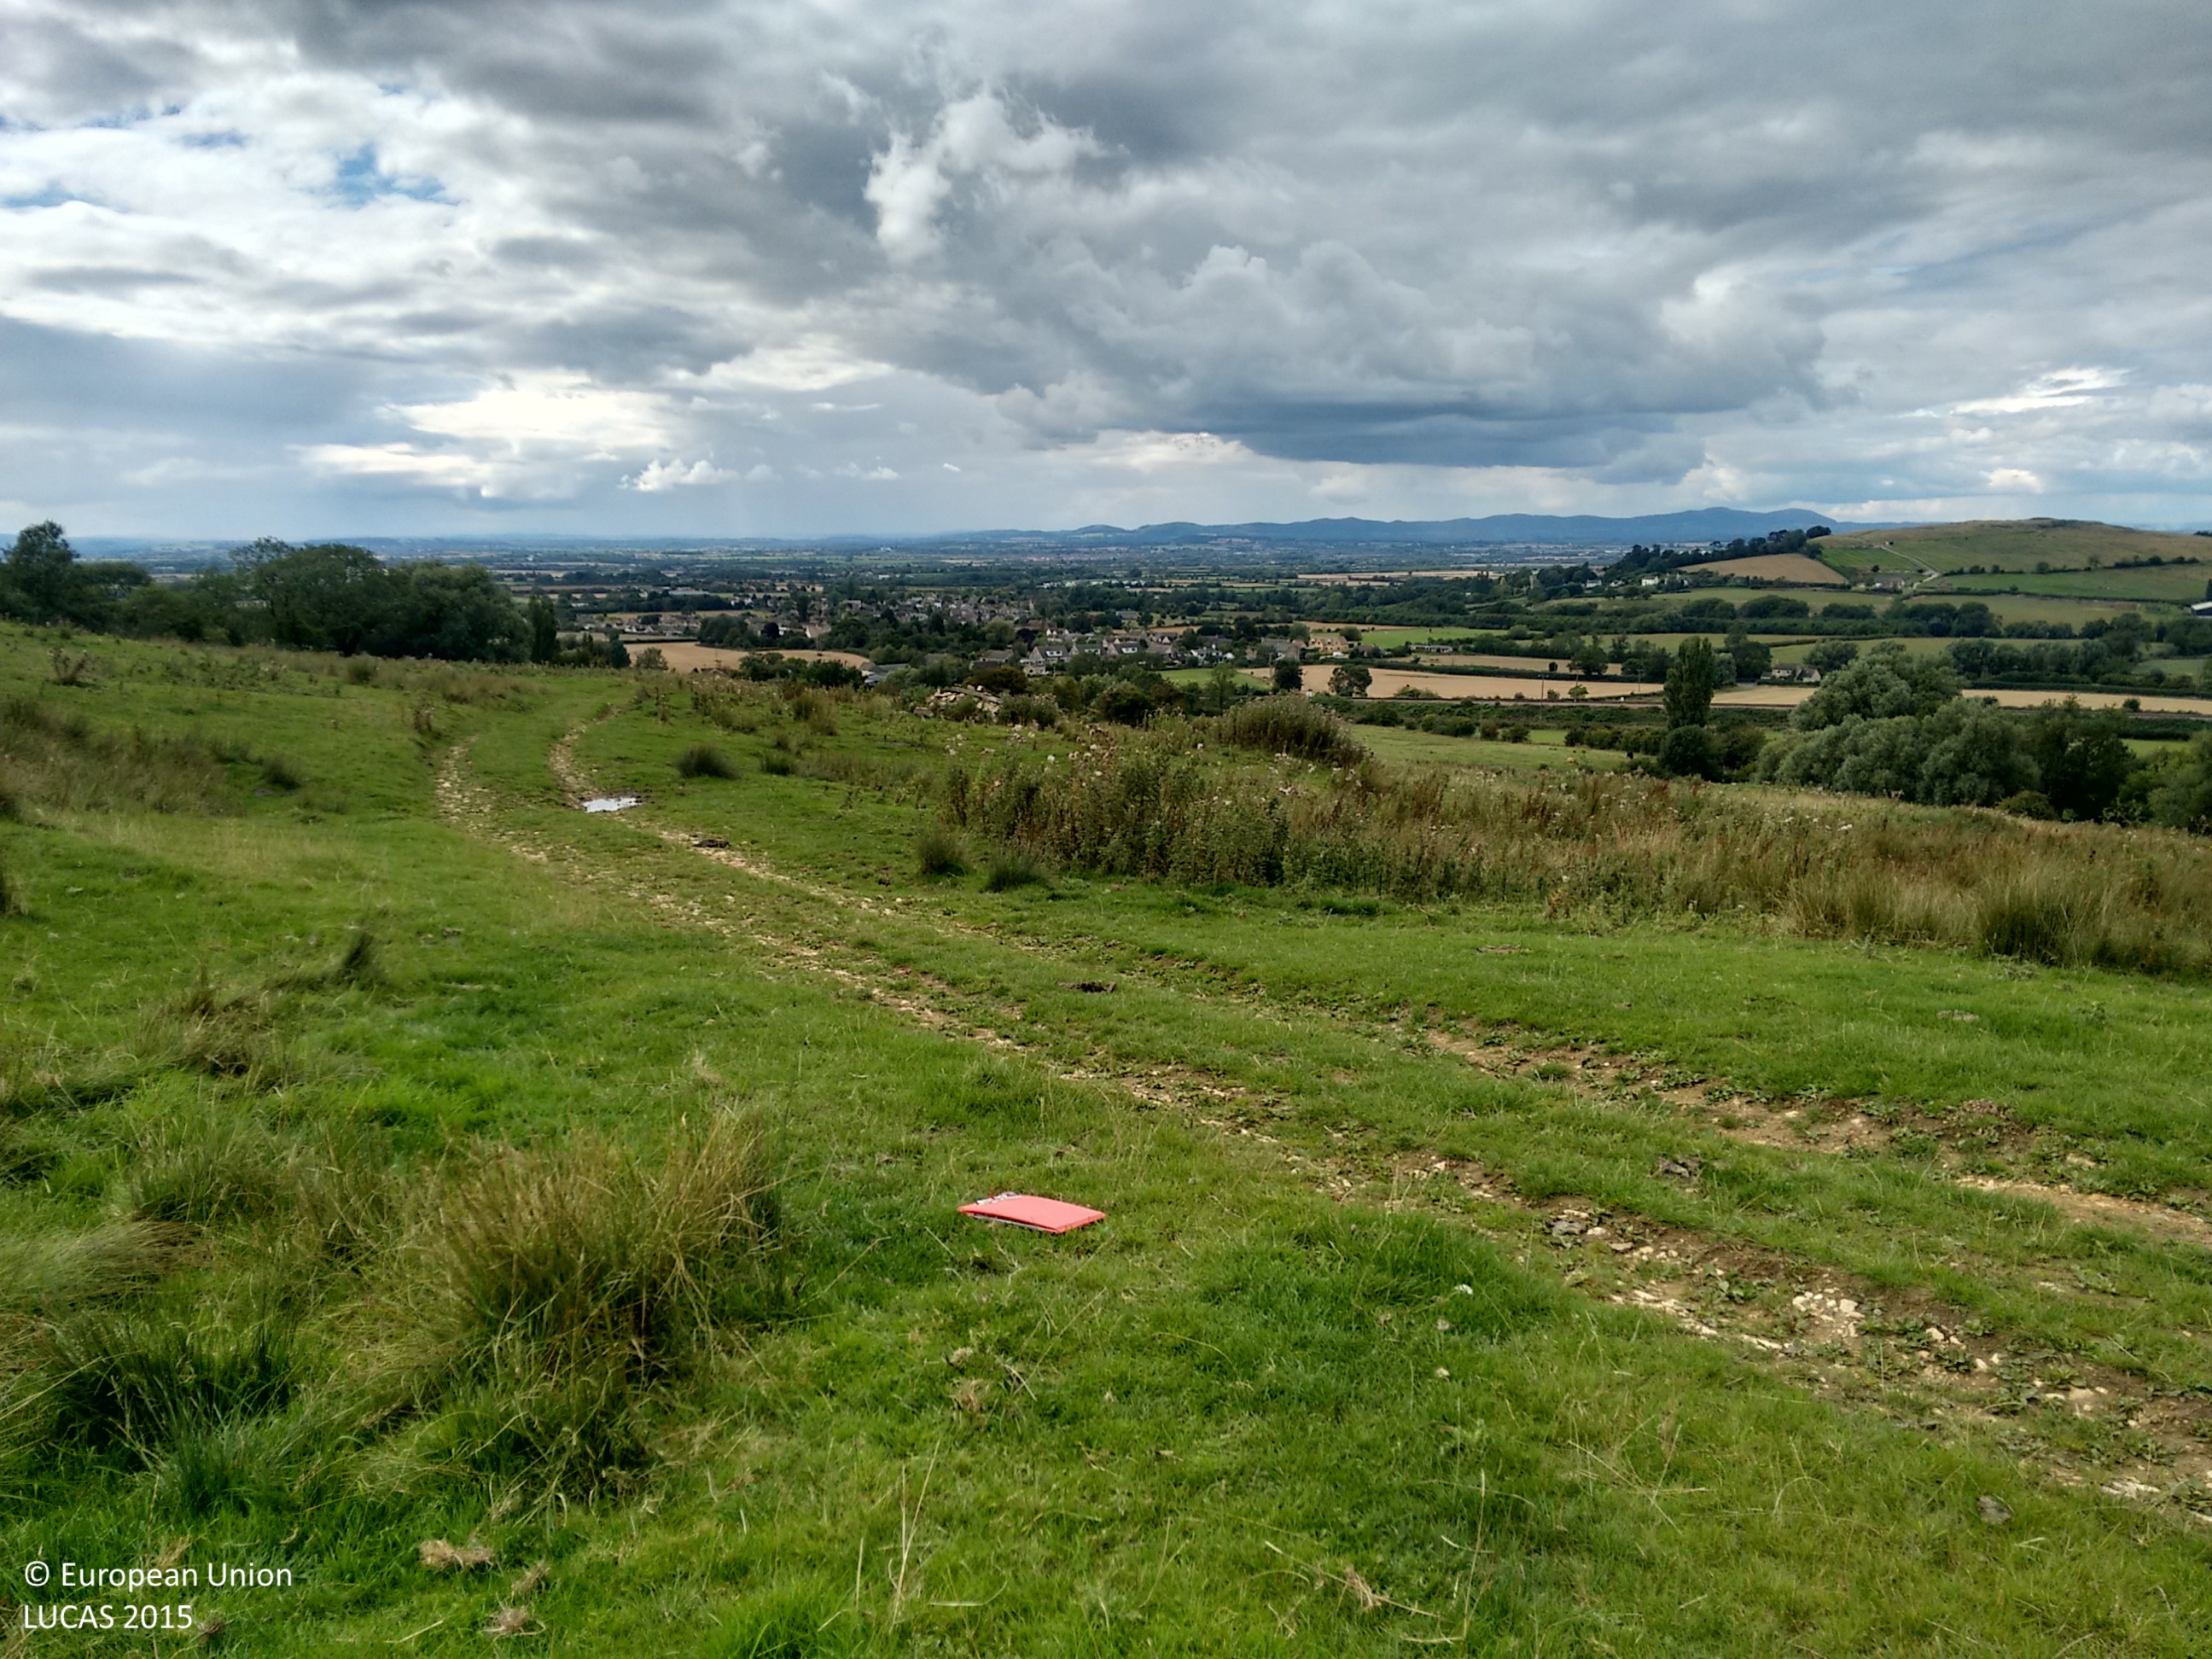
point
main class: Grassland
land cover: Grassland without tree/shrub cover
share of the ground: > 75 %
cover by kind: herbaceous plants 100 %
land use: Agriculture (excluding fallow land and kitchen gardens)
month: September
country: GB
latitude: 51.9623
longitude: -2.0366
